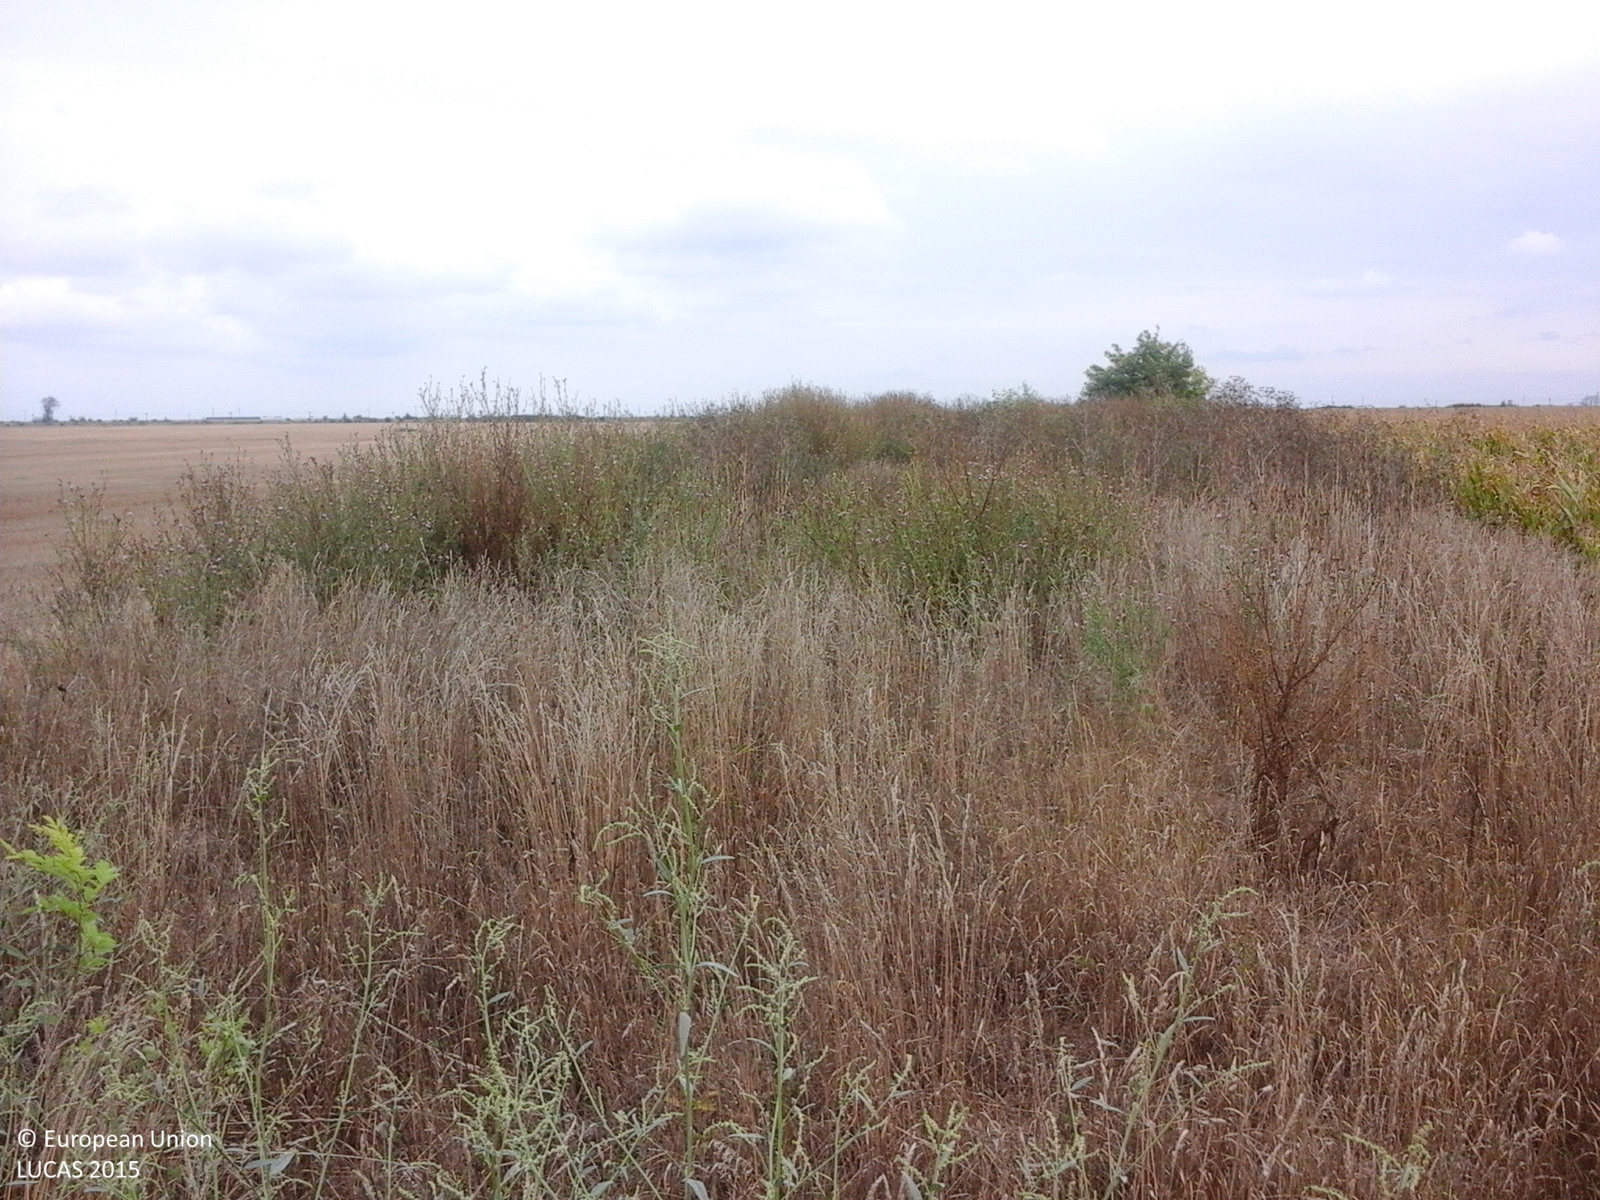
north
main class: Cropland
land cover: Maize
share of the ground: > 75 %
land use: Agriculture (excluding fallow land and kitchen gardens)
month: August
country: RO
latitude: 45.7854
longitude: 20.7921
